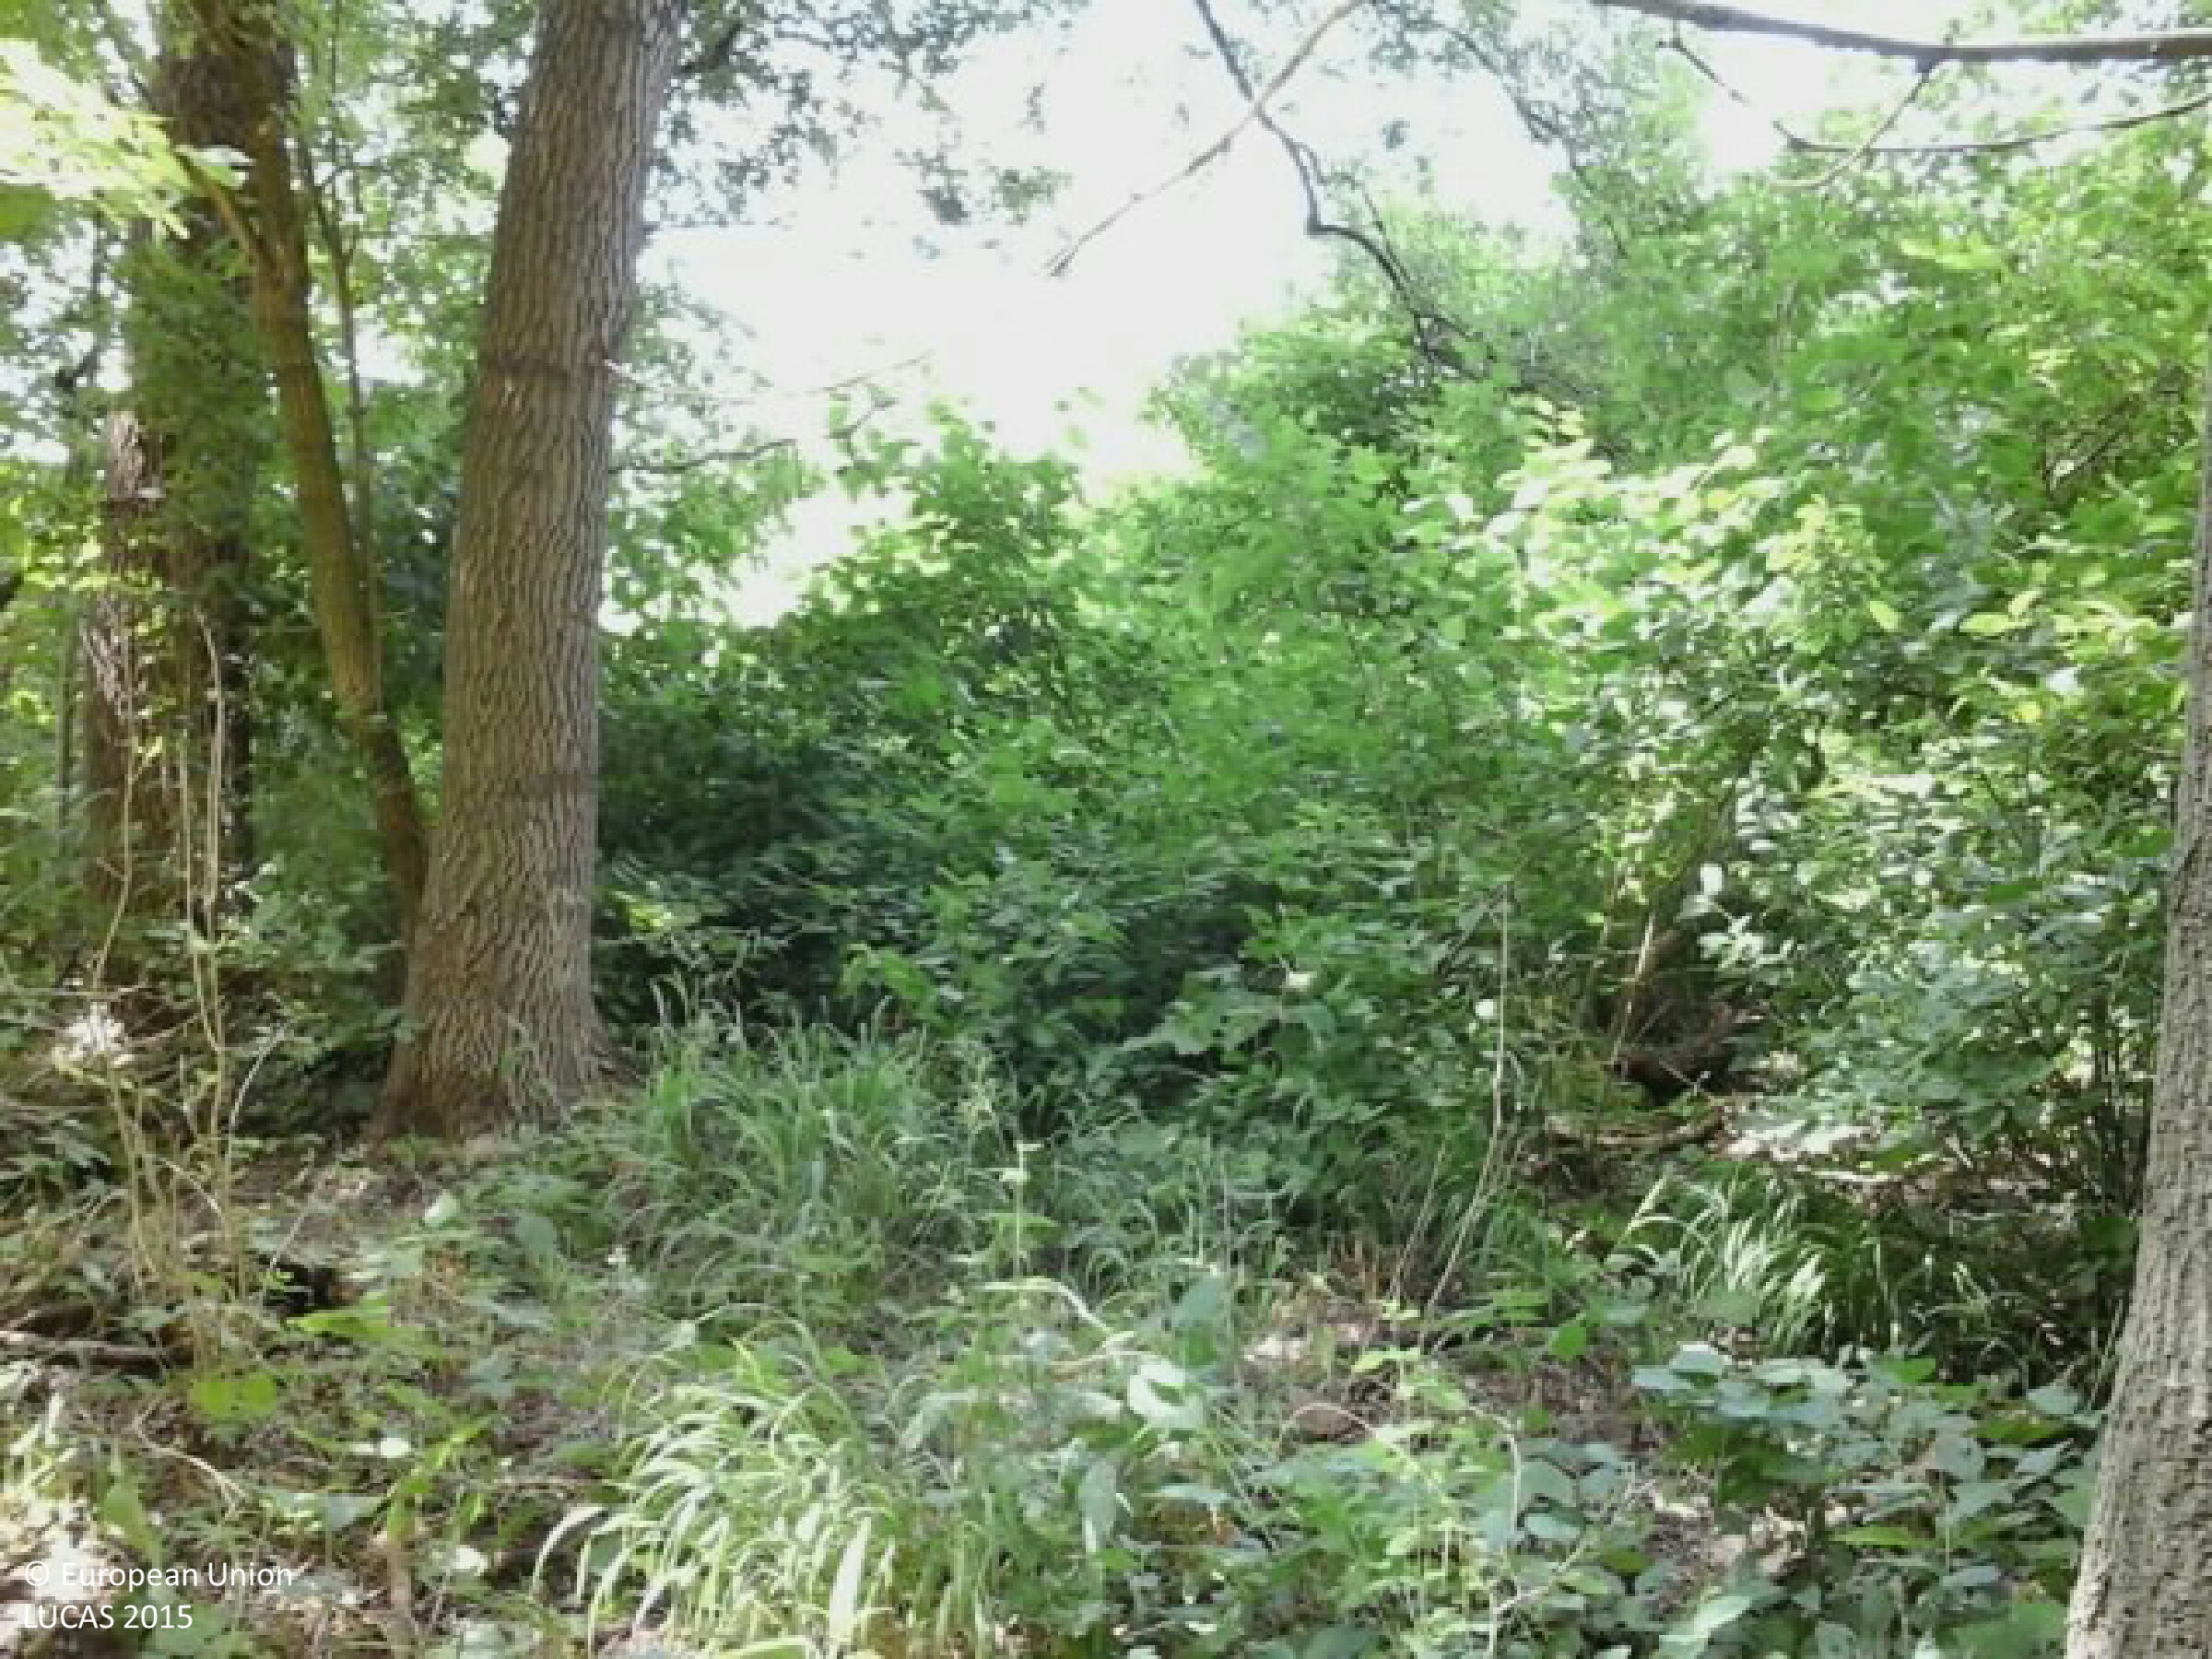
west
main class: Woodland
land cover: Broadleaved woodland
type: thermophilous deciduous forest
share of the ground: > 75 %
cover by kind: broadleaved forest trees 85 %, shrubs 10 %, herbaceous plants 5 %
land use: Forestry
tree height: > 5 m
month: July
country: HU
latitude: 47.2539
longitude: 19.2549
